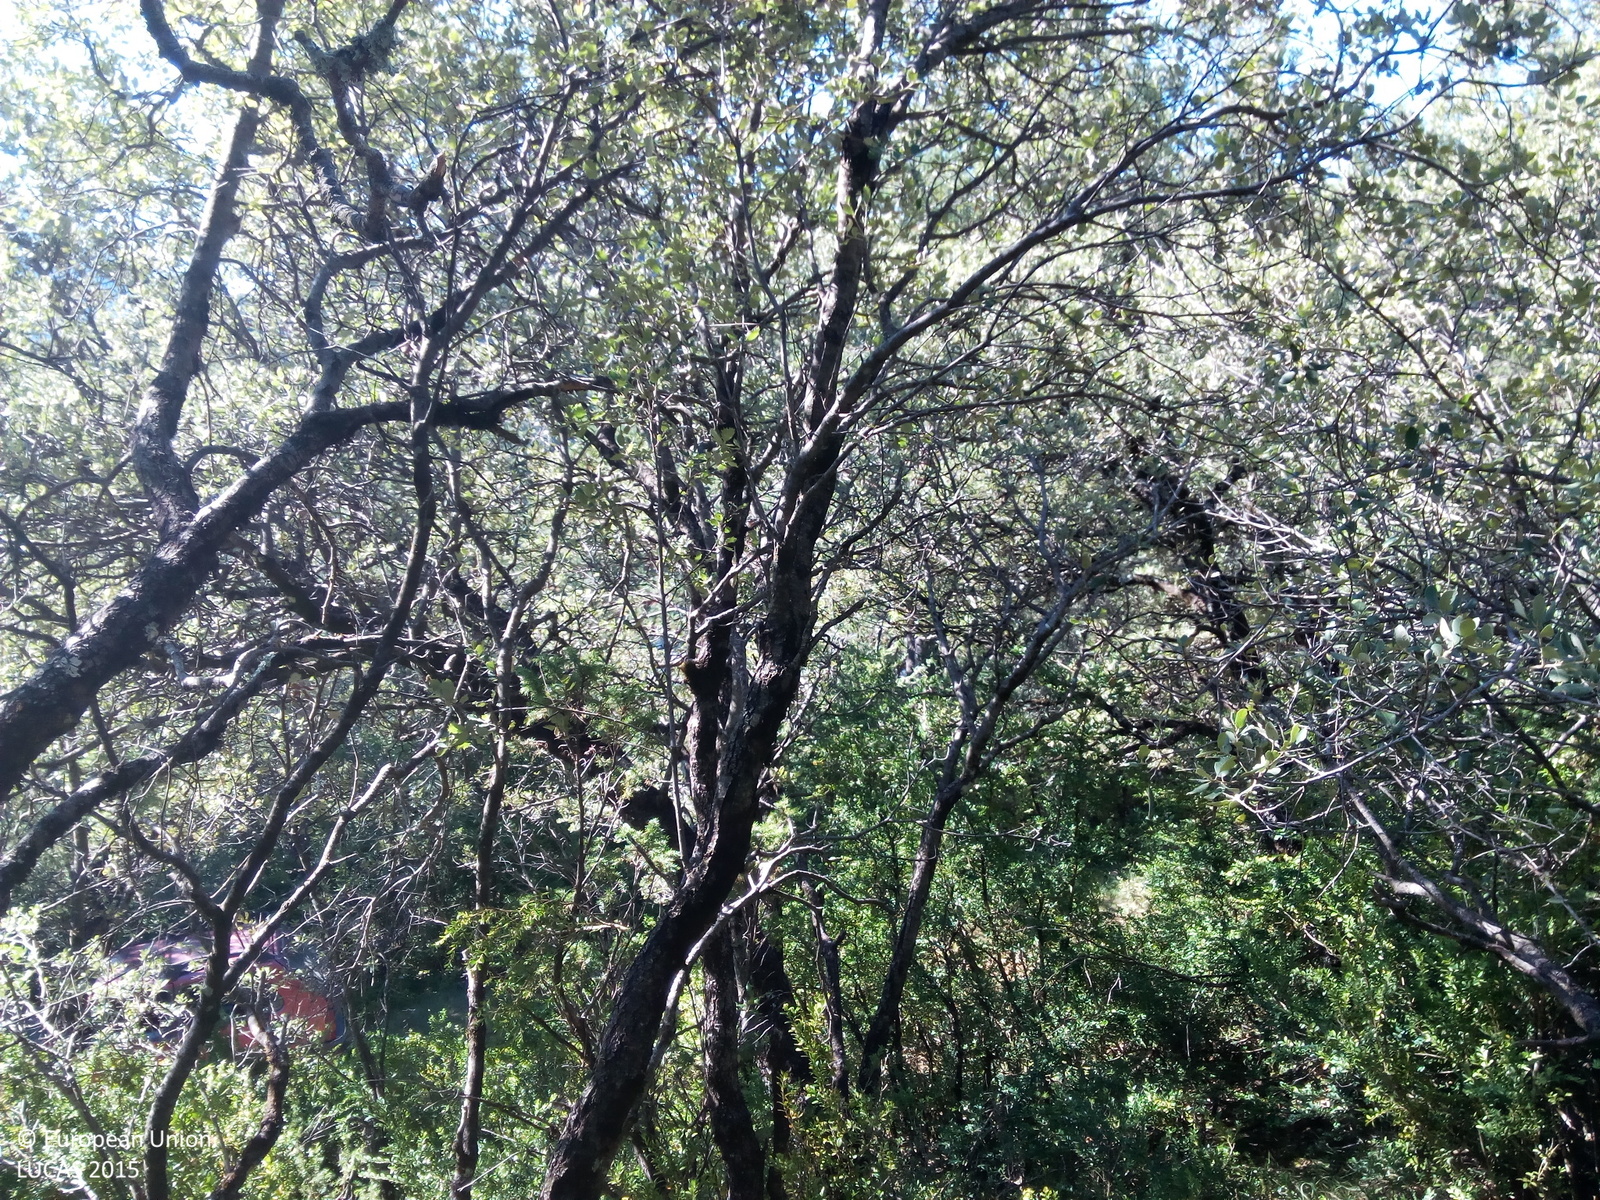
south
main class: Woodland
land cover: Pine dominated mixed woodland
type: alpine coniferous forest
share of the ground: > 75 %
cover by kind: broadleaved forest trees 40 %, coniferous forest trees 30 %, shrubs 20 %, herbaceous plants 10 %
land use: Semi-natural and natural areas not in use
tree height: > 5 m
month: August
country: ES
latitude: 42.5771
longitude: 0.1946
